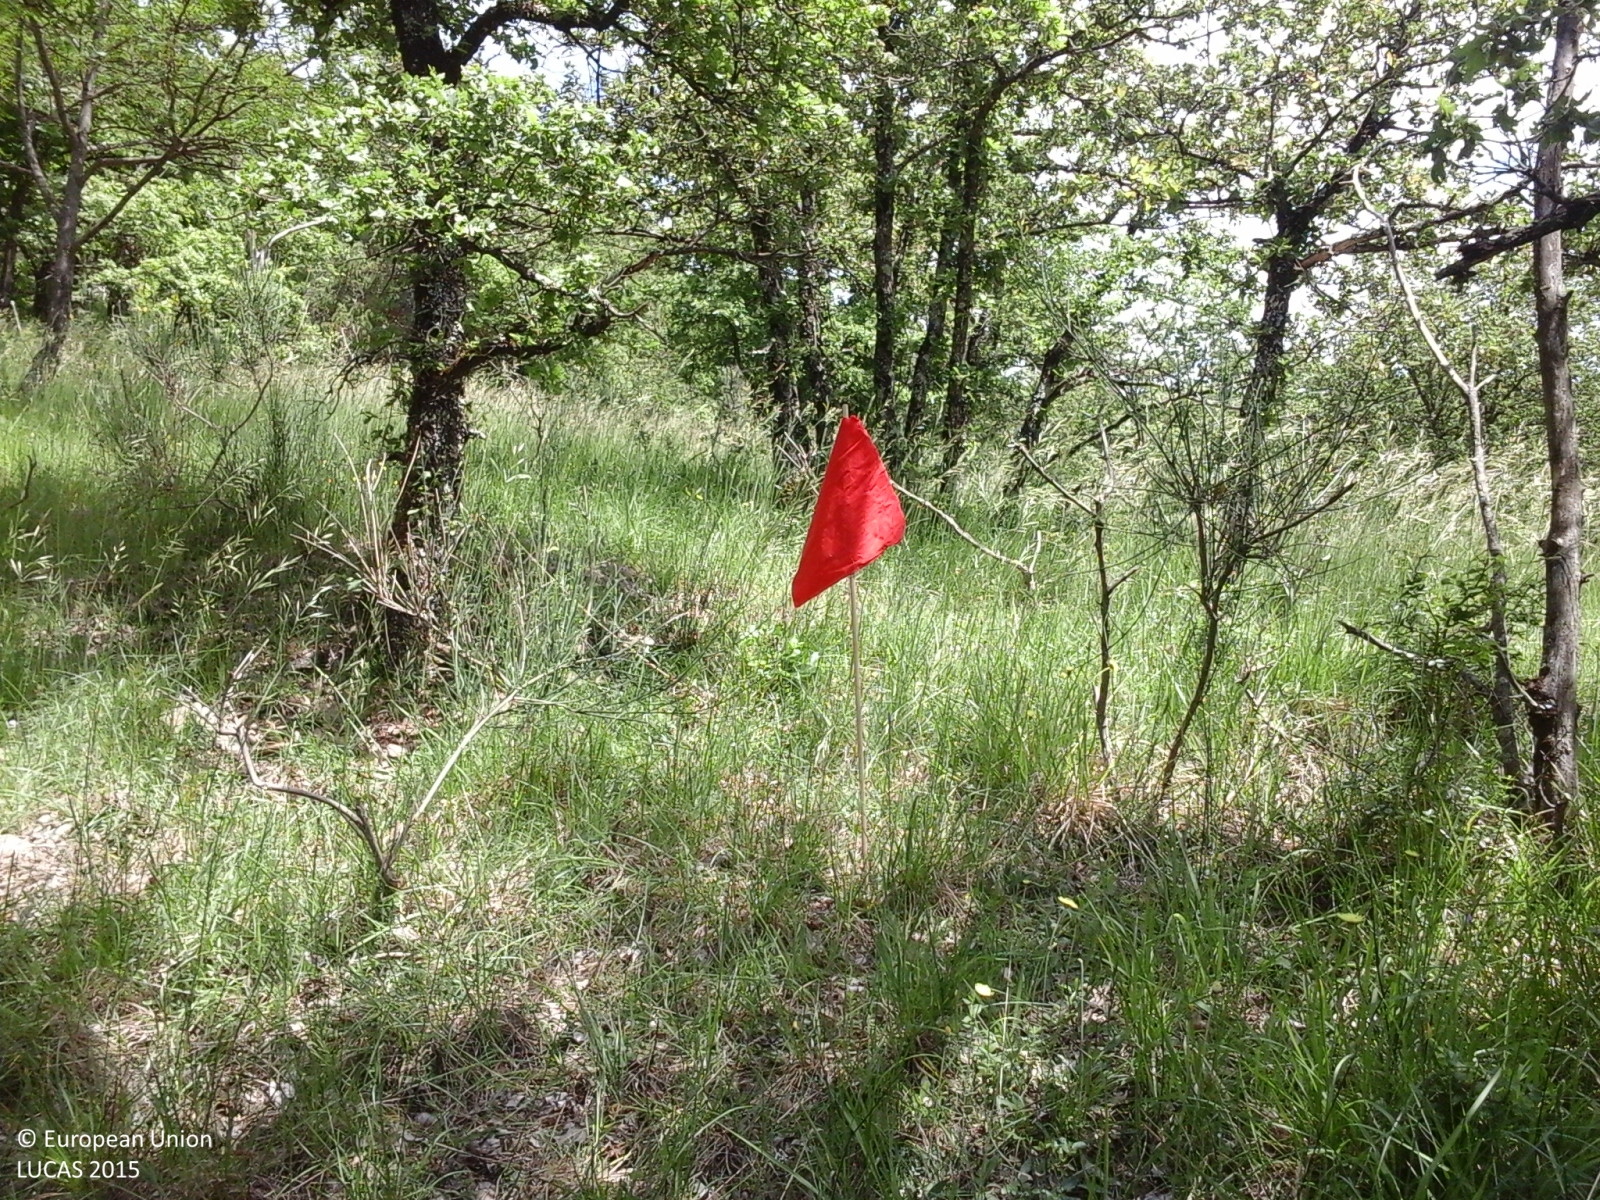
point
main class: Woodland
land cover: Broadleaved woodland
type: thermophilous deciduous forest
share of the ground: > 75 %
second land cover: Grassland without tree/shrub cover
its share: > 75 %
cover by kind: broadleaved forest trees 70 %, herbaceous plants 20 %, shrubs 10 %
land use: Forestry
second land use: Agriculture (excluding fallow land and kitchen gardens)
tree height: > 5 m
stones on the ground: 10 - 25 %
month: May
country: IT
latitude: 44.0380
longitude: 11.1079
